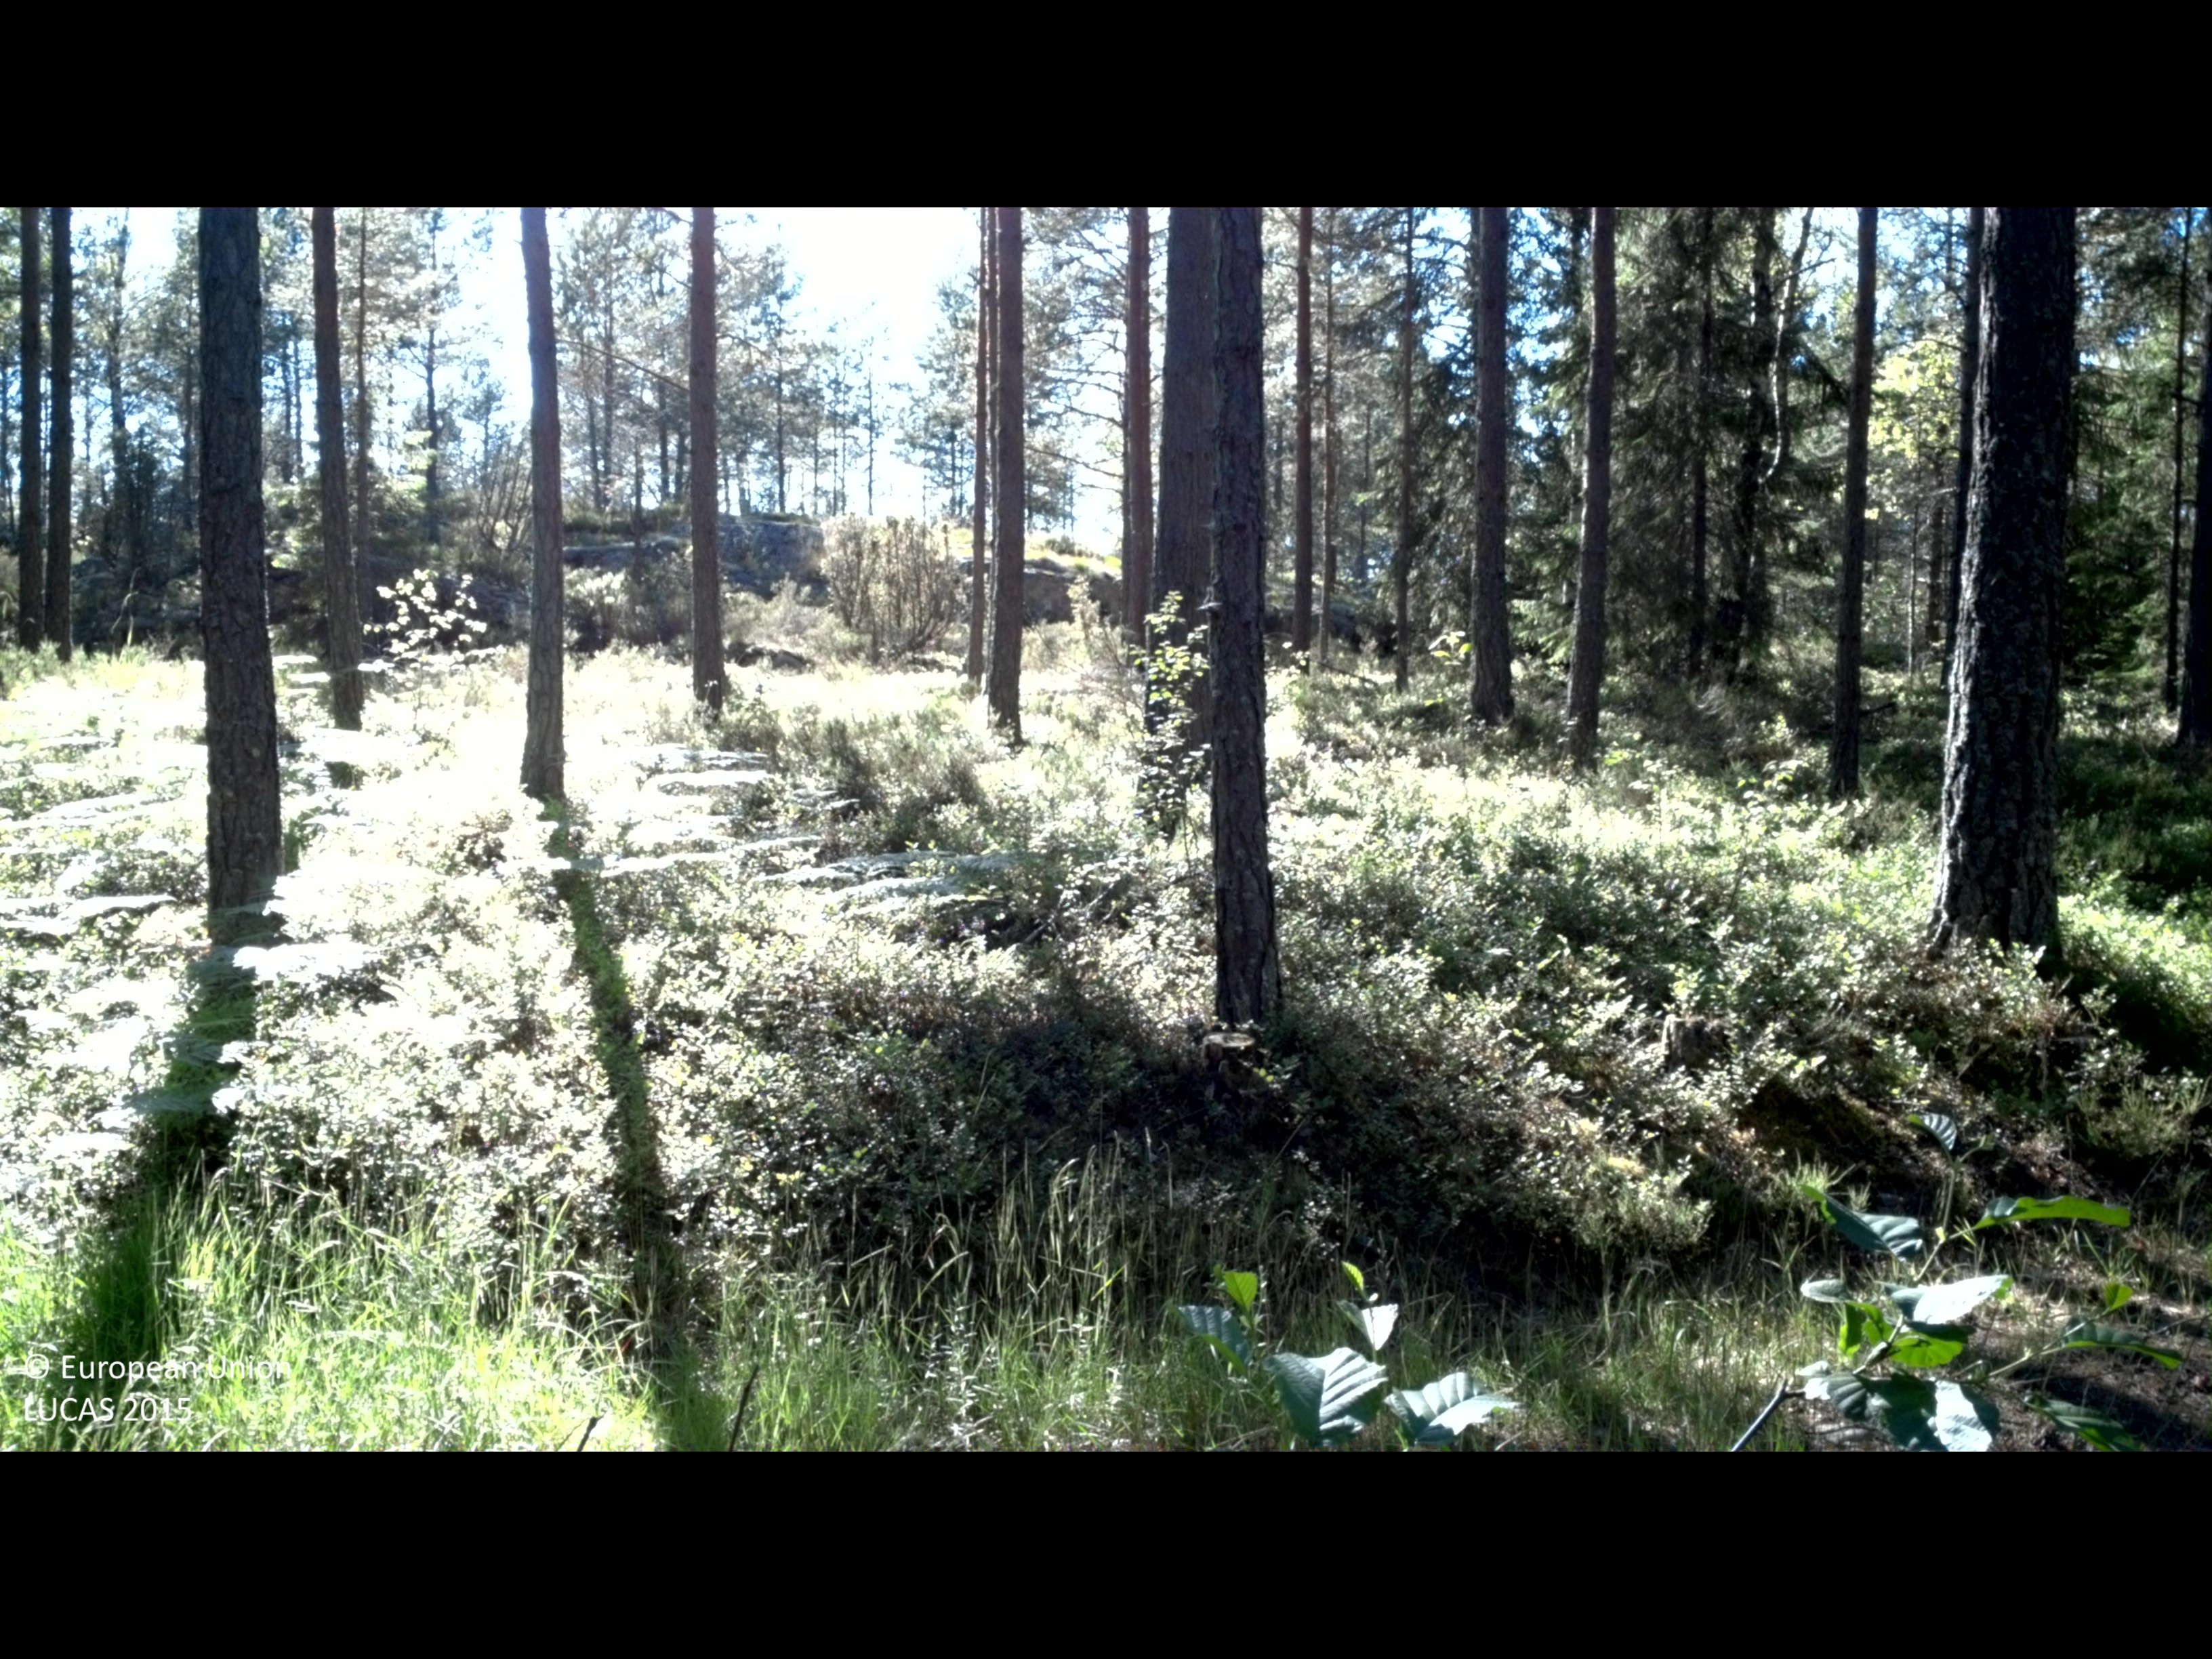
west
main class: Woodland
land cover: Pine dominated mixed woodland
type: boreal forest
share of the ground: 50 - 75 %
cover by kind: coniferous forest trees 50 %, shrubs 25 %, broadleaved forest trees 20 %, herbaceous plants 5 %
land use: Forestry
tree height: > 5 m
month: July
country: SE
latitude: 58.2351
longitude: 16.6566
